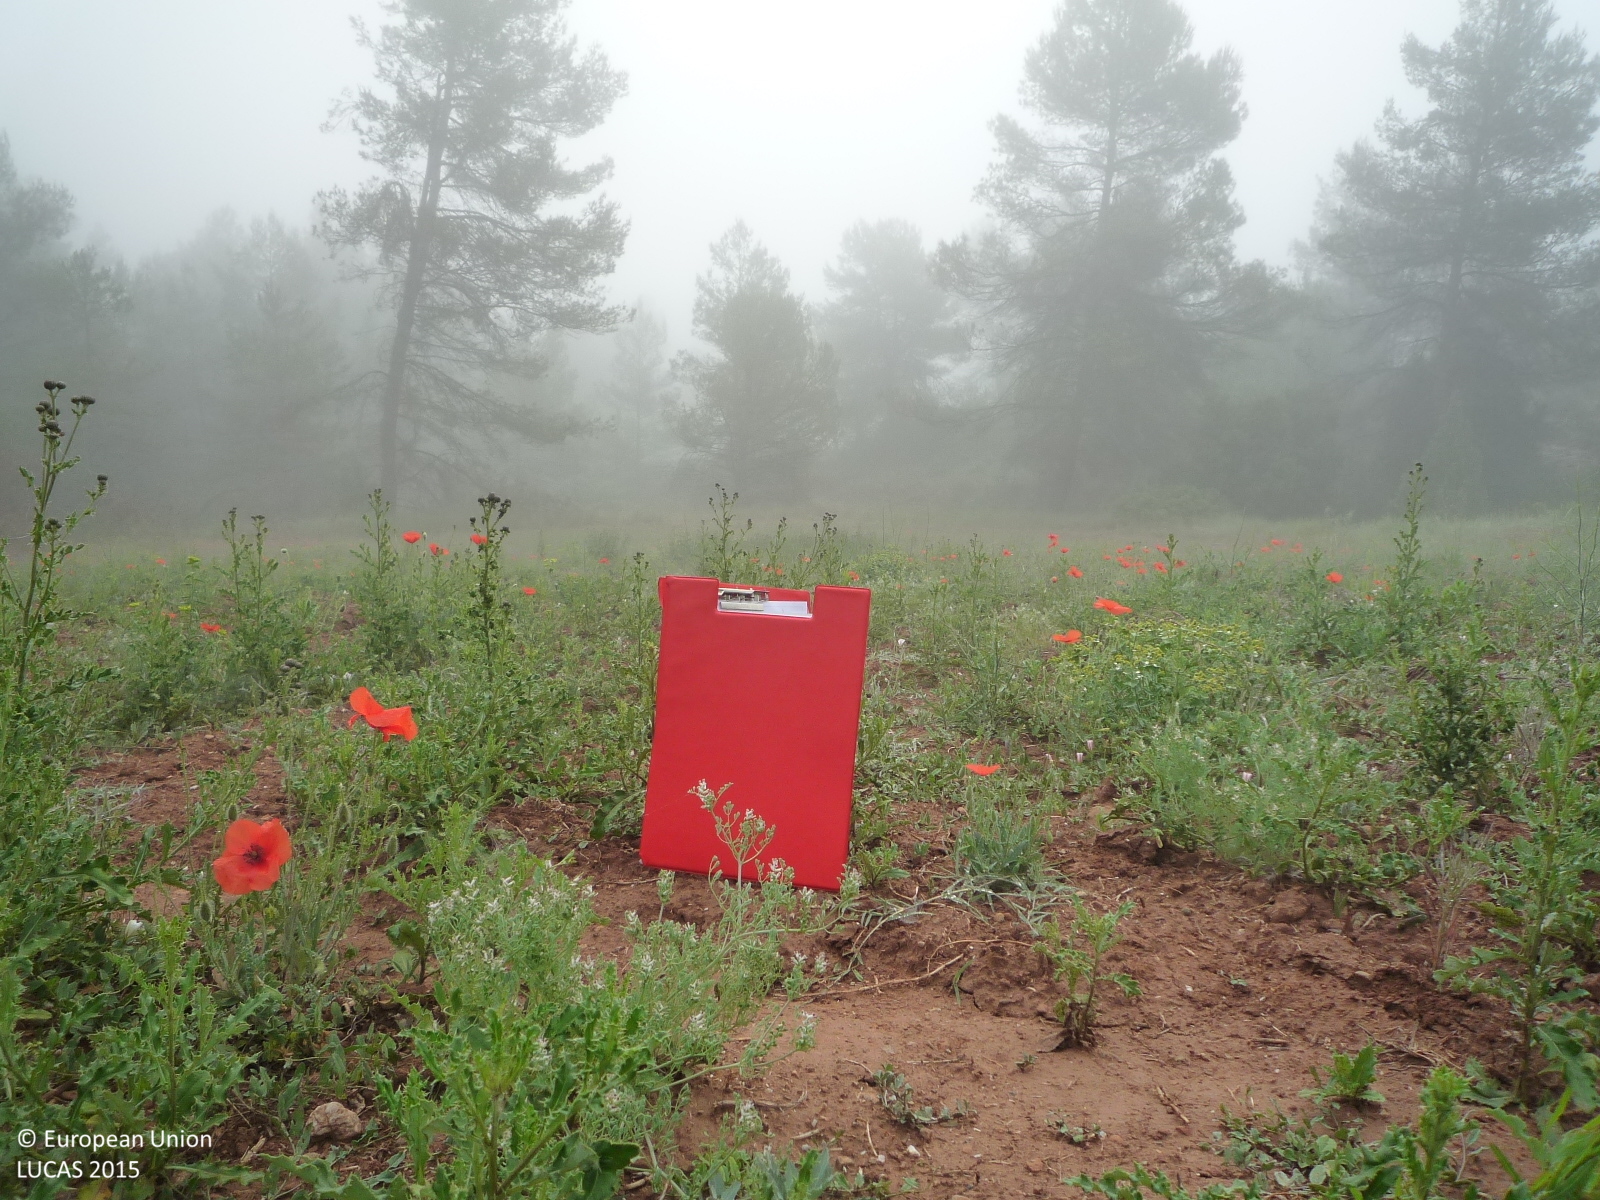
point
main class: Grassland
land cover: Grassland without tree/shrub cover
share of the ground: > 75 %
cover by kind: herbaceous plants 100 %
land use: Abandoned areas
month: June
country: ES
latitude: 41.6648
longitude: 1.7646
